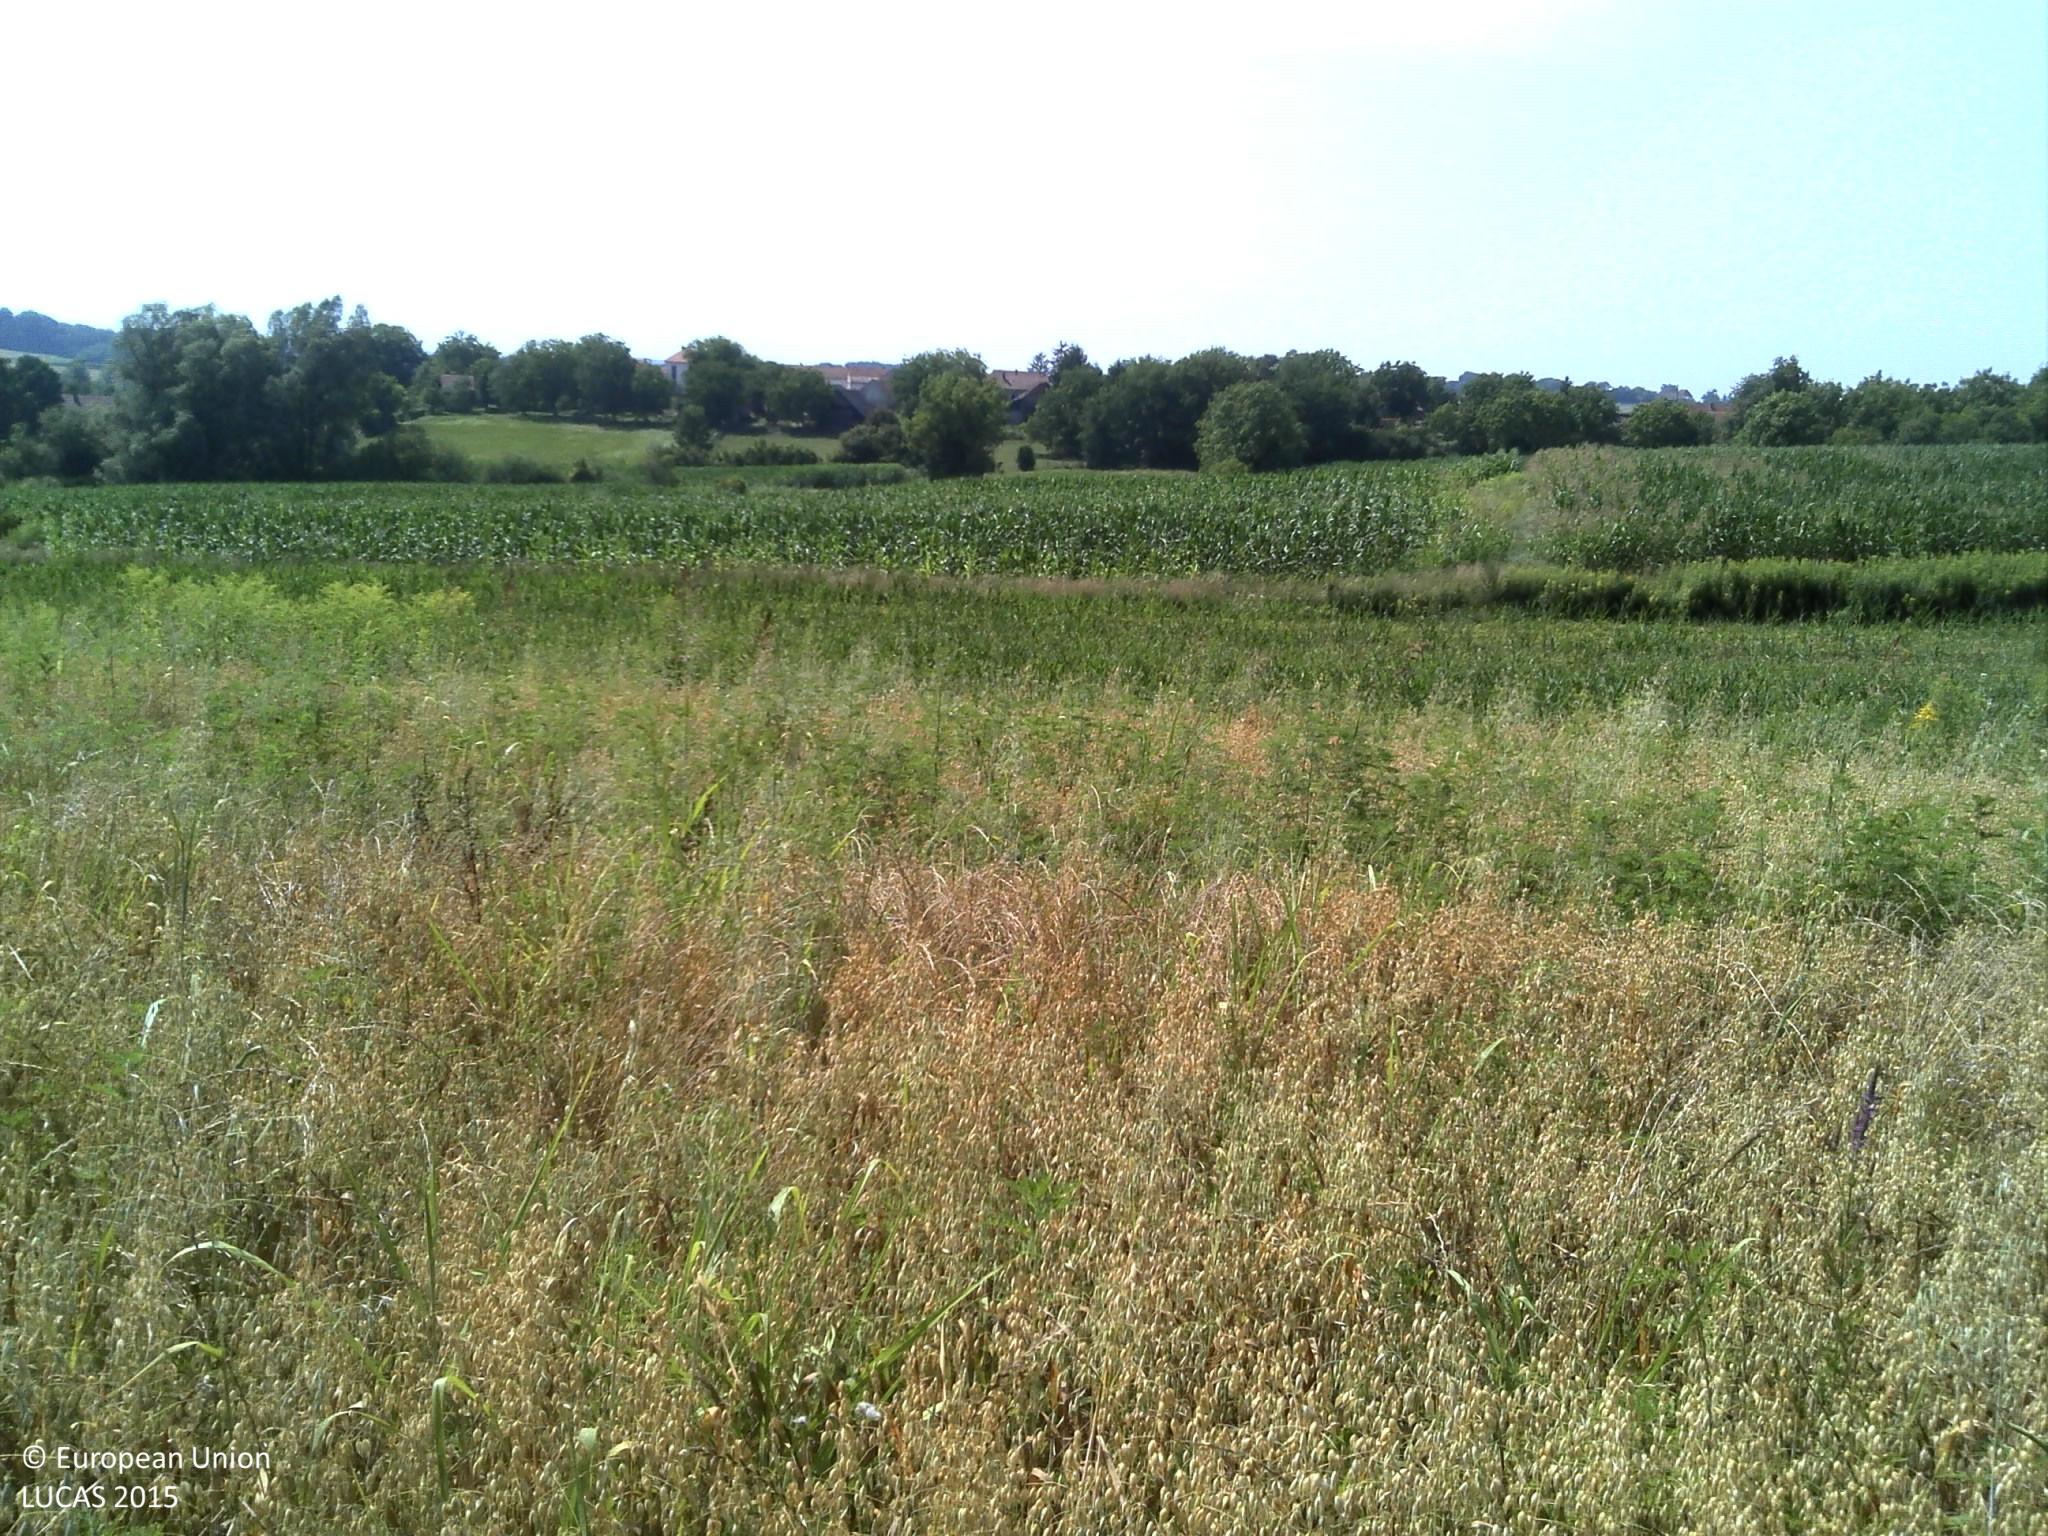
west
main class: Cropland
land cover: Oats
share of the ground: > 75 %
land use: Agriculture (excluding fallow land and kitchen gardens)
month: July
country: HR
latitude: 46.0111
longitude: 16.7551
